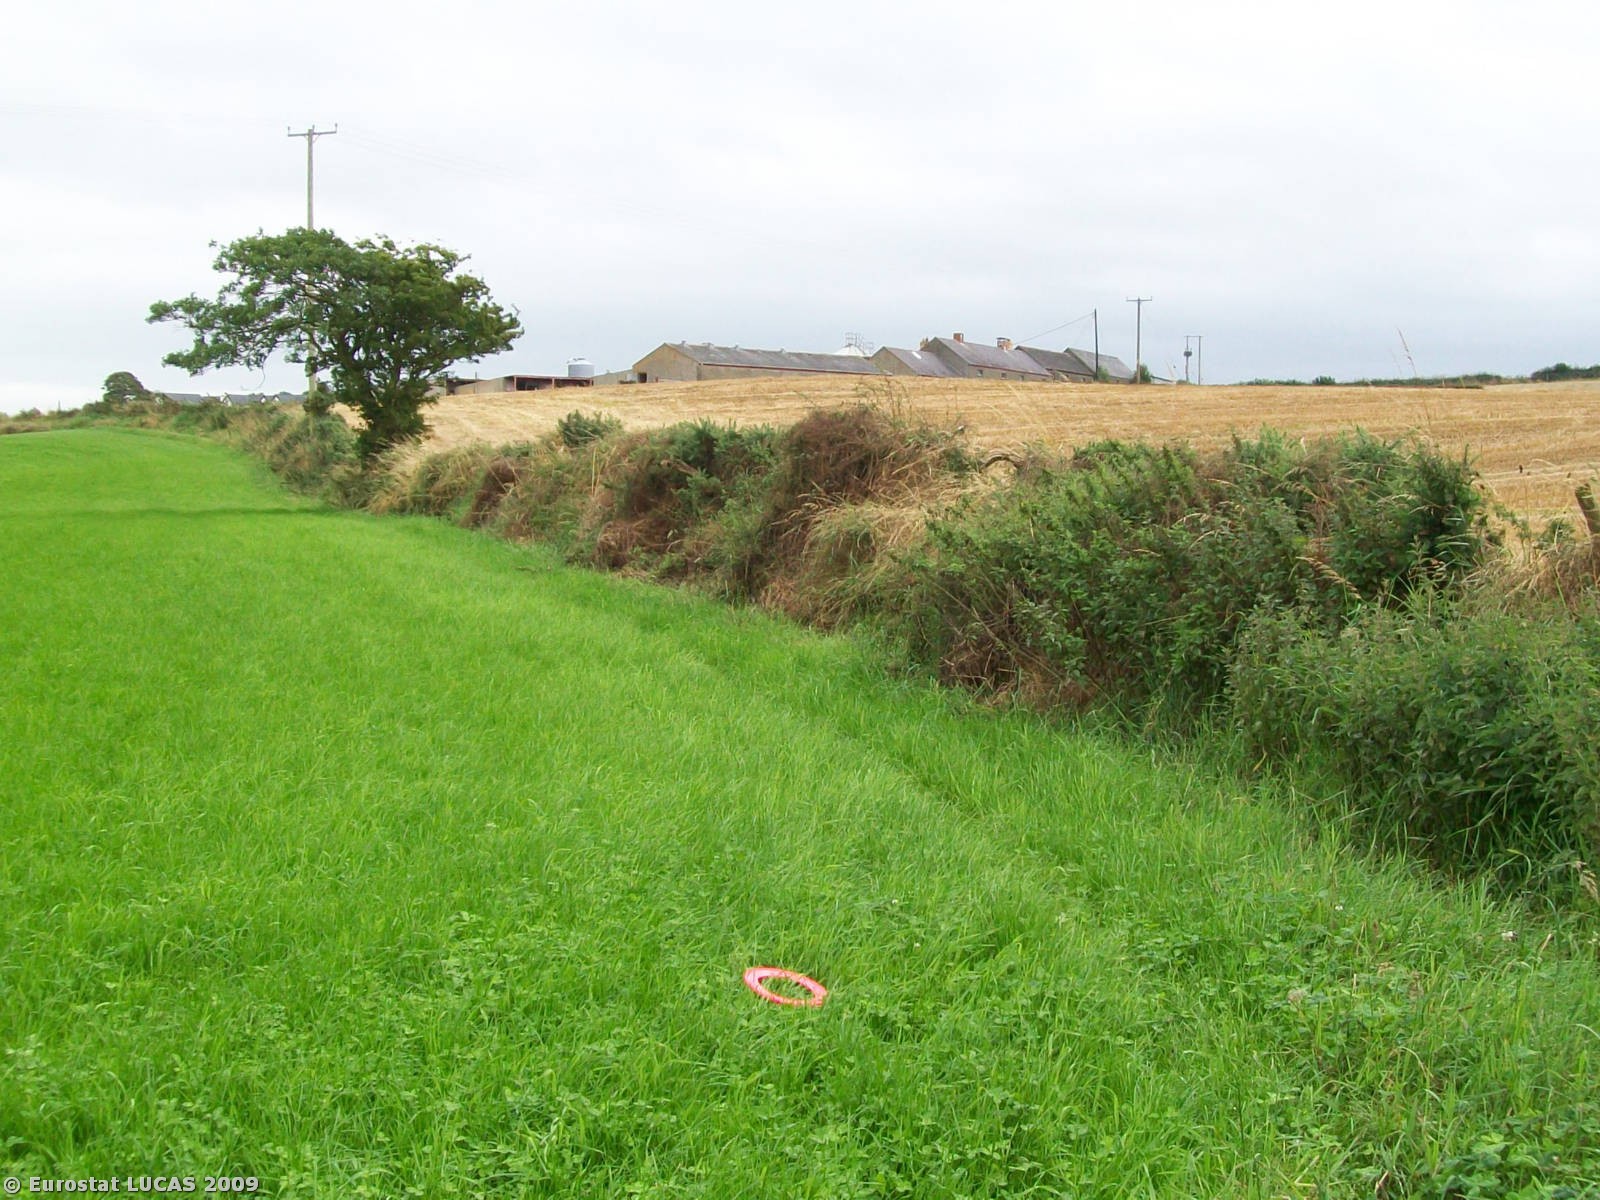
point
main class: Grassland
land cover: Grassland without tree/shrub cover
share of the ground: > 75 %
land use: Agriculture (excluding fallow land and kitchen gardens)
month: August
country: GB
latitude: 54.5200
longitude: -5.9435
